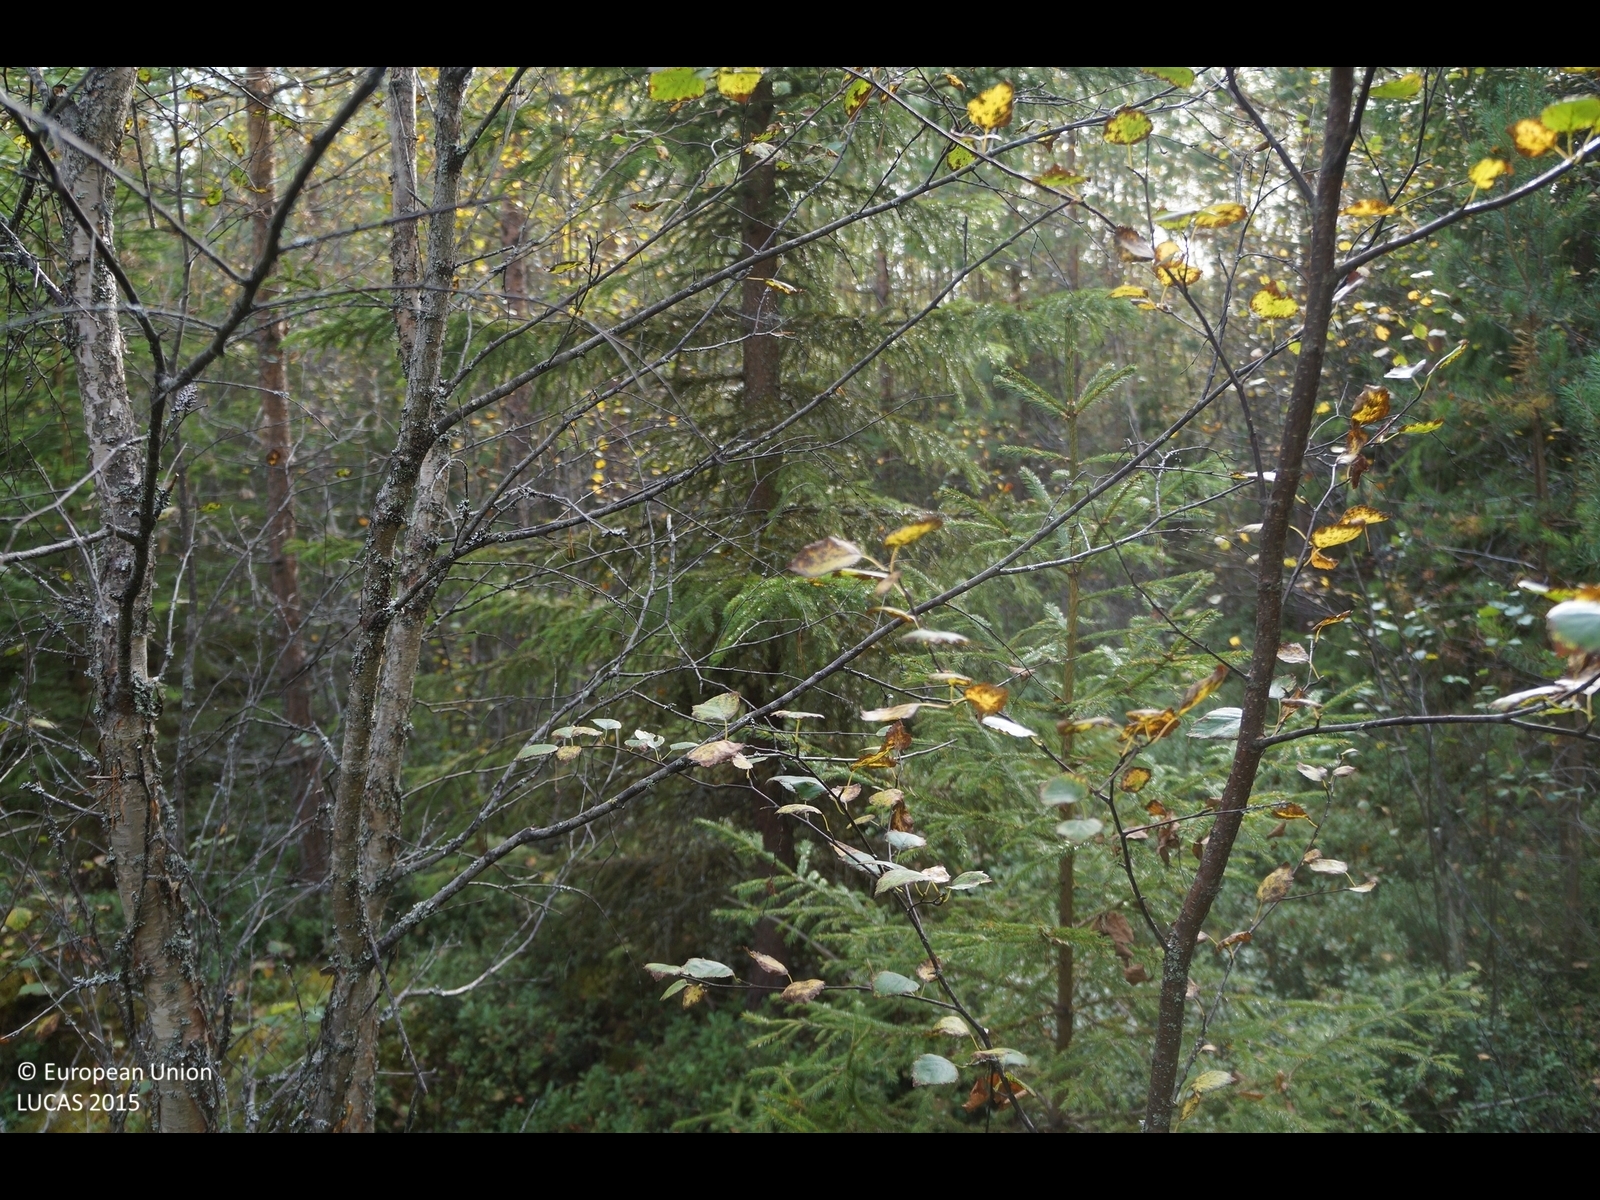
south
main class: Woodland
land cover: Spruce dominated mixed woodland
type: boreal forest
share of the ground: 50 - 75 %
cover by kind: shrubs 40 %, coniferous forest trees 30 %, broadleaved forest trees 20 %, lichens and mosses 10 %
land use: Forestry
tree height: > 5 m
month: September
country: FI
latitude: 64.0522
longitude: 23.7646
